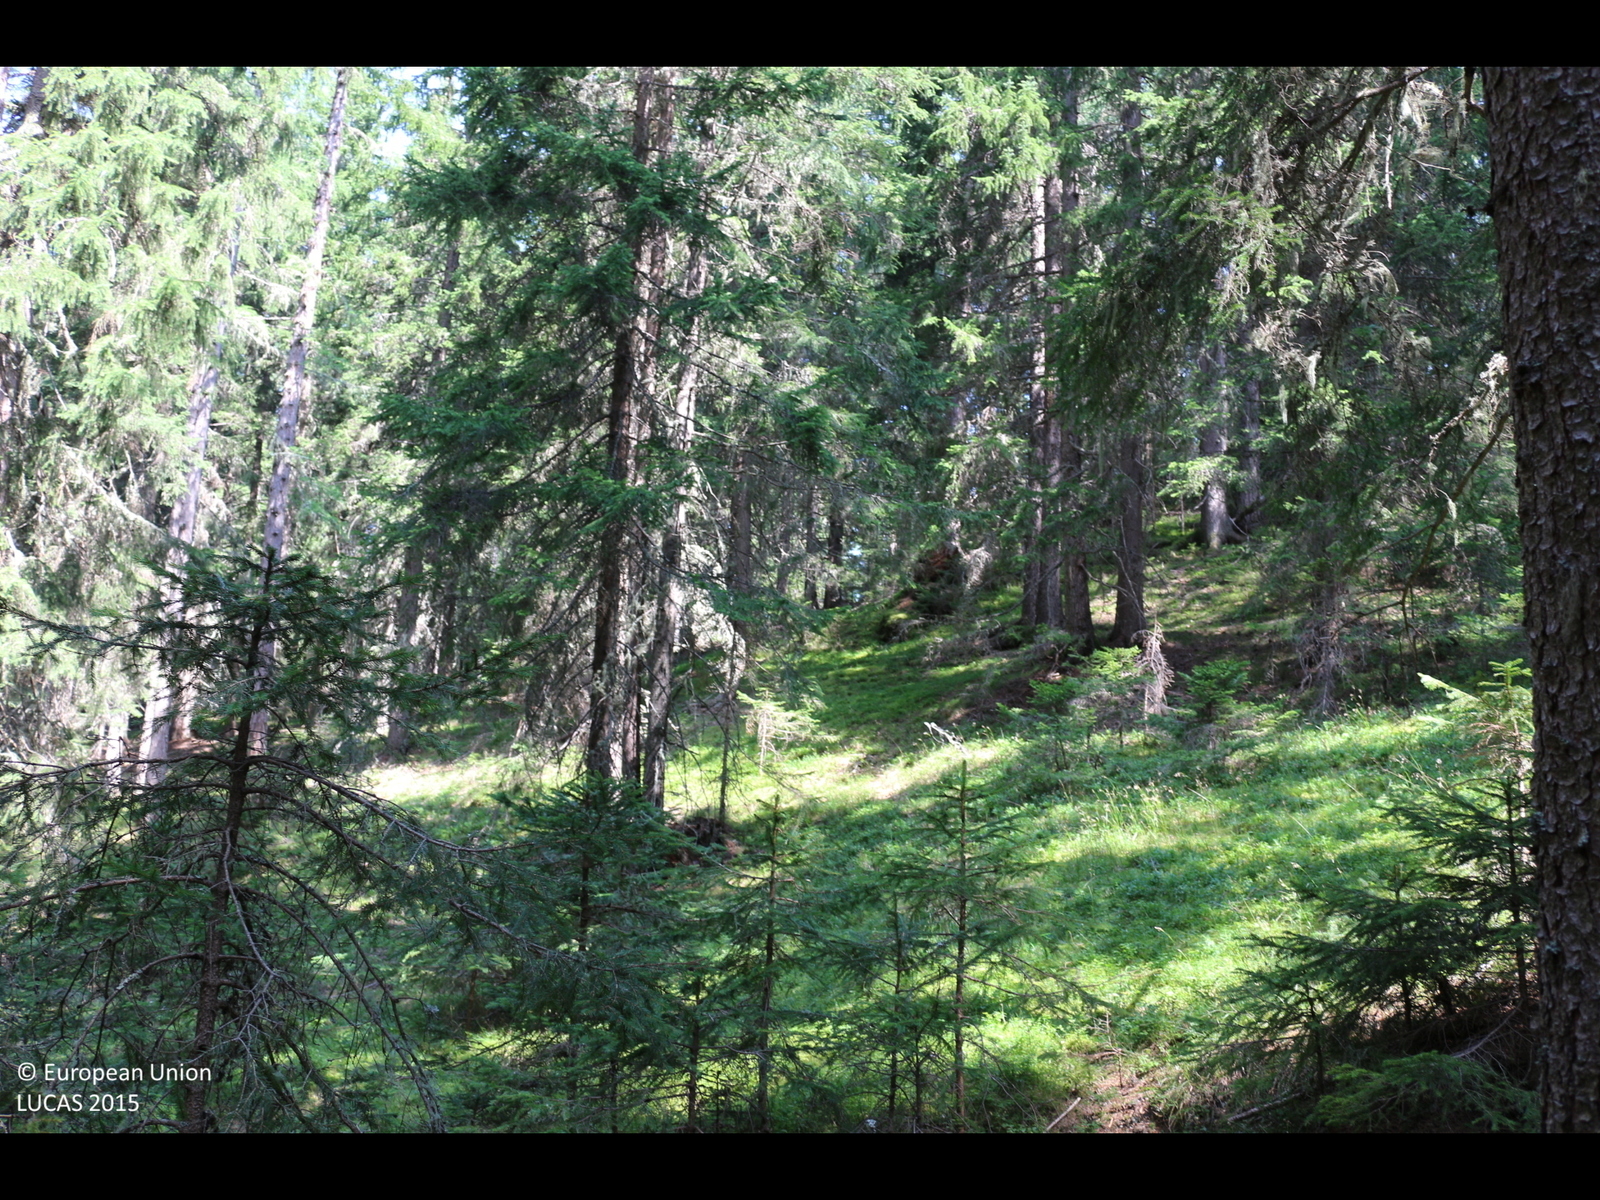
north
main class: Woodland
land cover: Other coniferous woodland
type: alpine coniferous forest
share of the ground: > 75 %
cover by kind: coniferous forest trees 95 %, shrubs 5 %
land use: Forestry
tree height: > 5 m
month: August
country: AT
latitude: 47.0093
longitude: 14.1677
